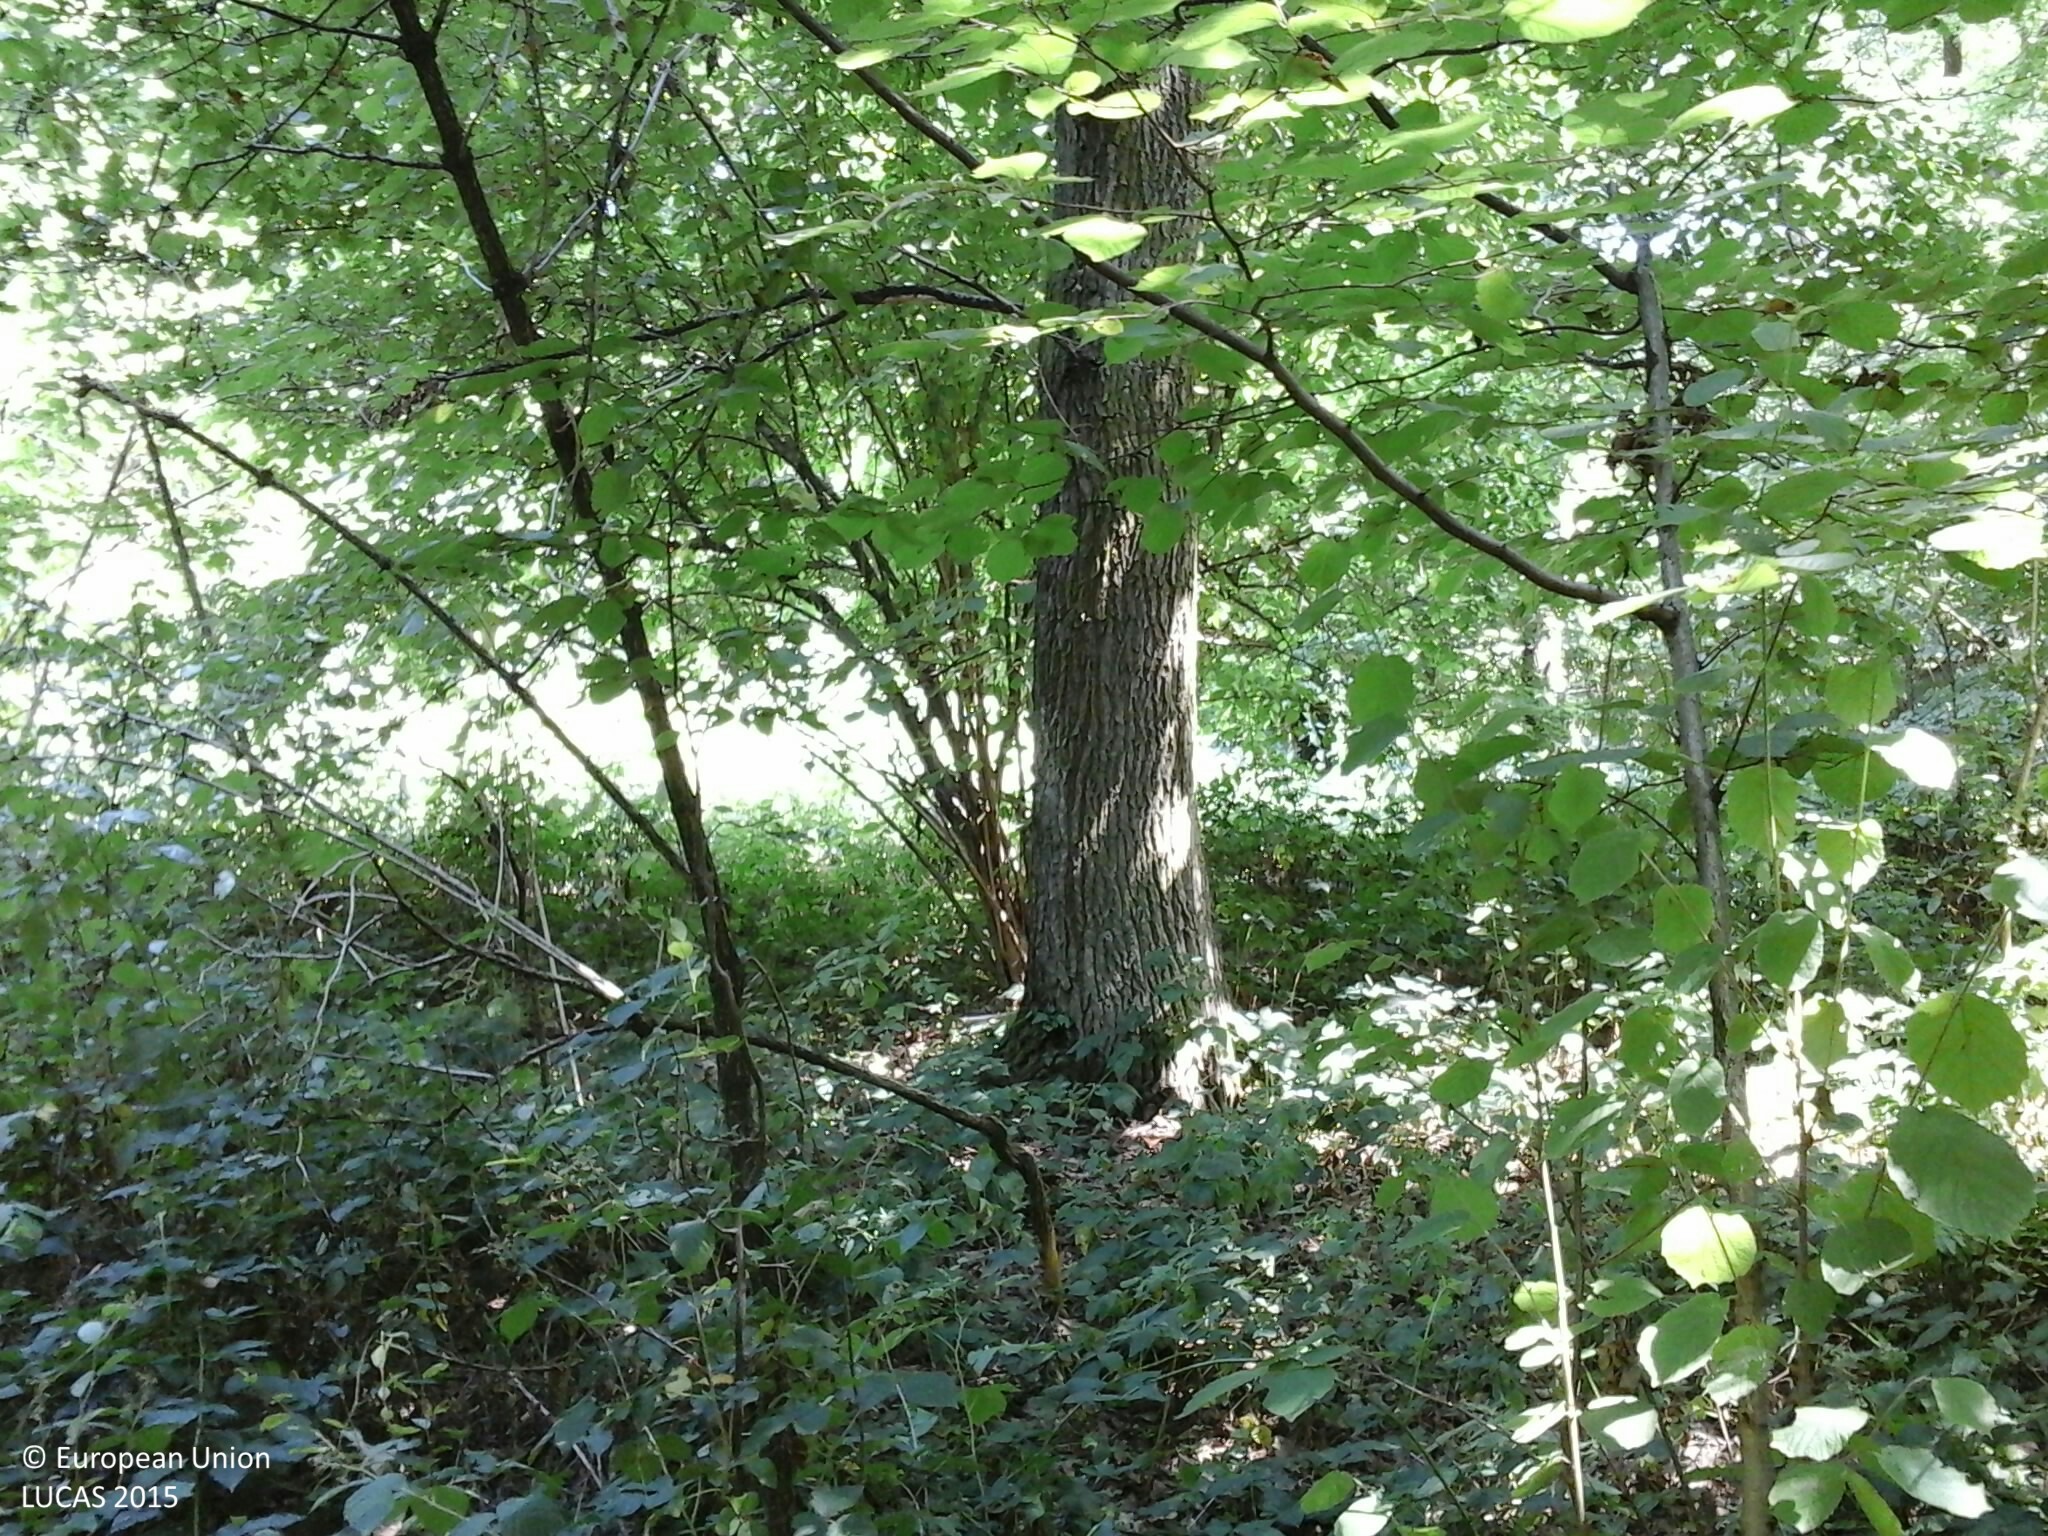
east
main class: Woodland
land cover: Broadleaved woodland
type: mesophytic deciduous forest
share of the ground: > 75 %
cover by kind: broadleaved forest trees 80 %, shrubs 20 %
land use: Forestry
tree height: > 5 m
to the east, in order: Broadleaved woodland
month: July
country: HU
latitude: 46.9937
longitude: 16.6435
